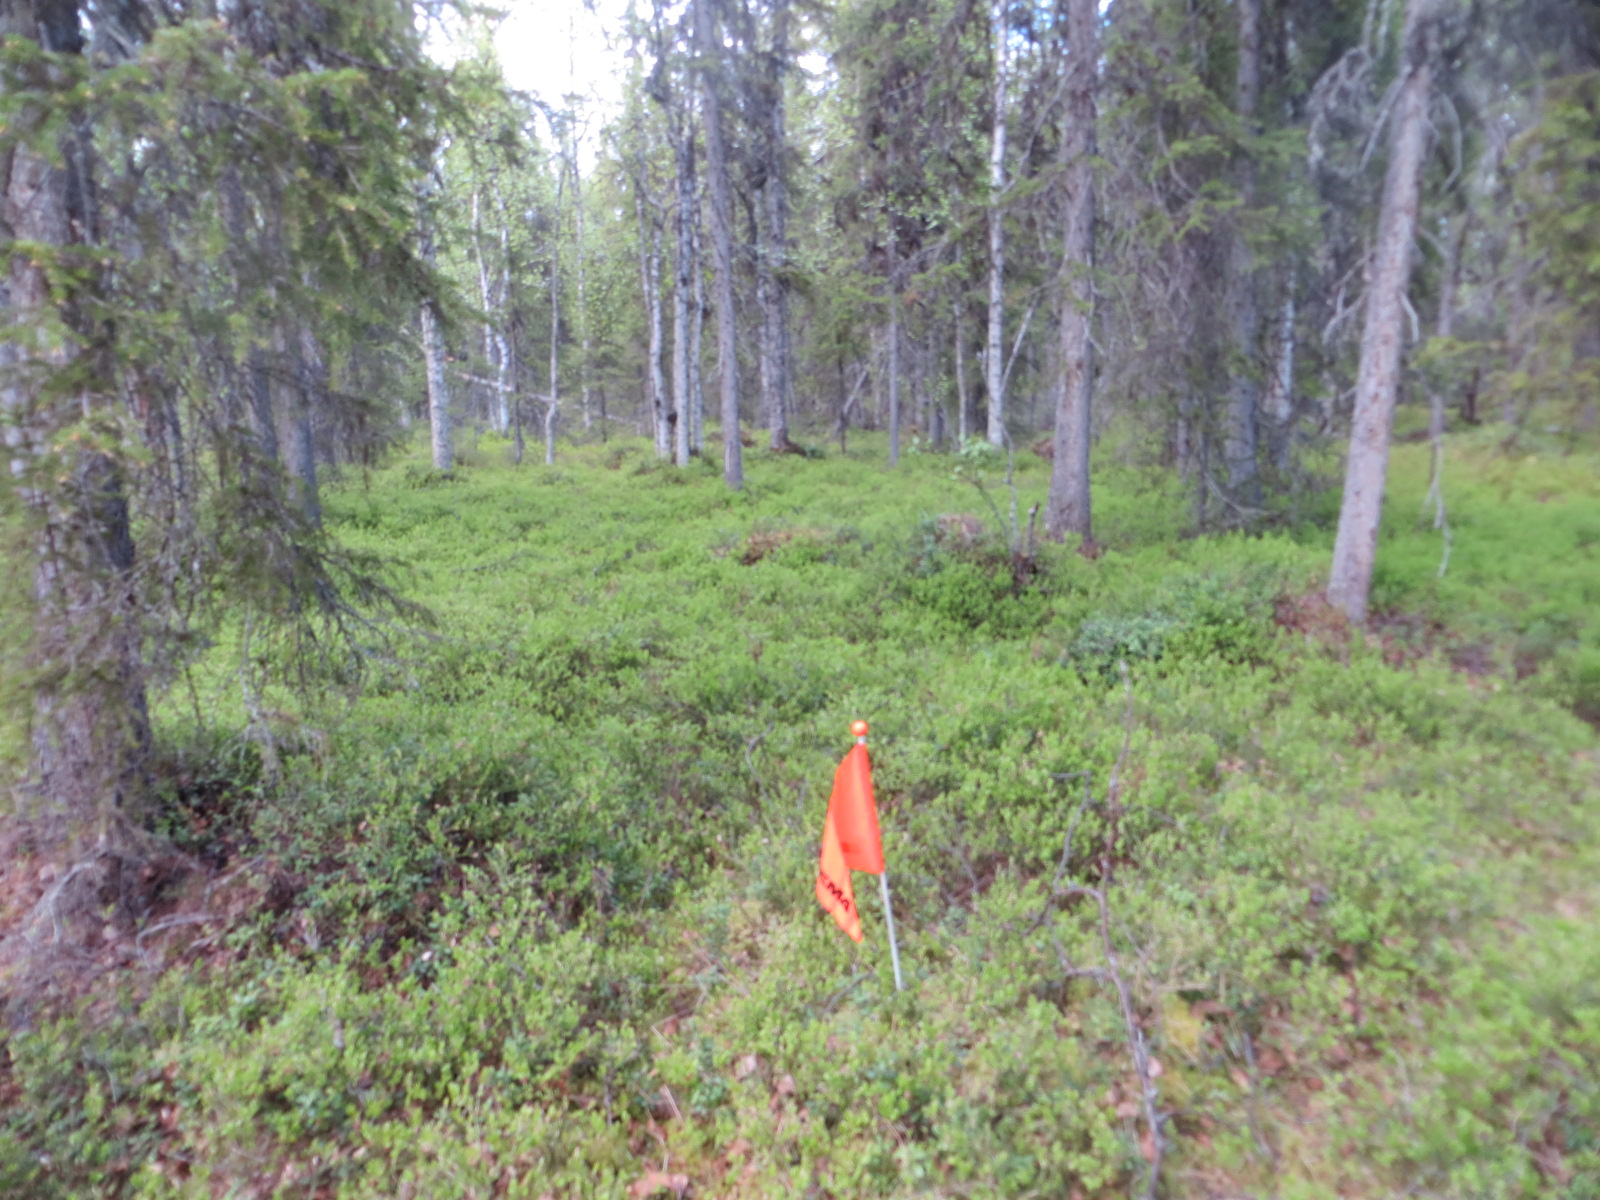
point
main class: Woodland
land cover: Spruce dominated mixed woodland
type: boreal forest
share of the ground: 50 - 75 %
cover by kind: coniferous forest trees 60 %, broadleaved forest trees 20 %, shrubs 20 %
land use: Forestry
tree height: > 5 m
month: June
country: FI
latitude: 67.4881
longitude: 25.8548
